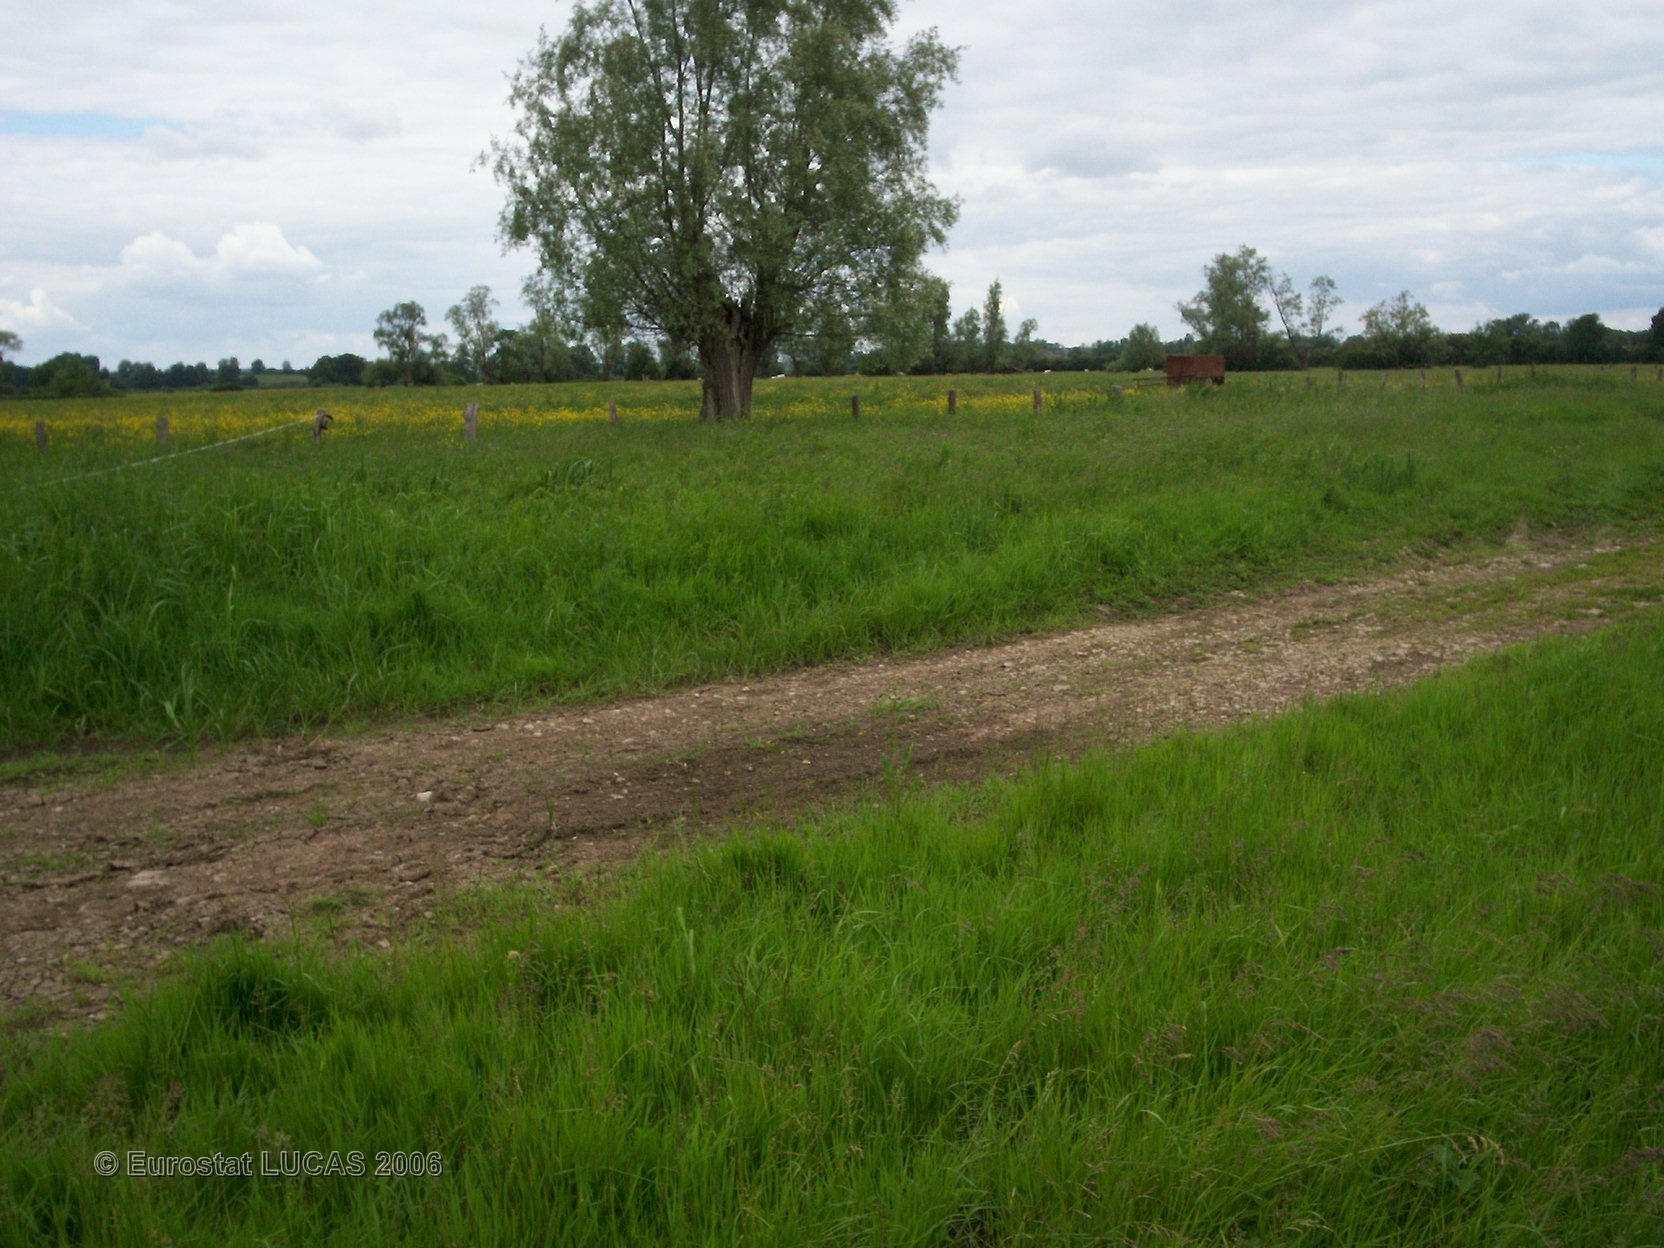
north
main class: Grassland
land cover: Grassland without tree/shrub cover
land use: Agriculture (excluding fallow land and kitchen gardens)
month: May
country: FR
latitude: 46.8664
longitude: 3.0566
